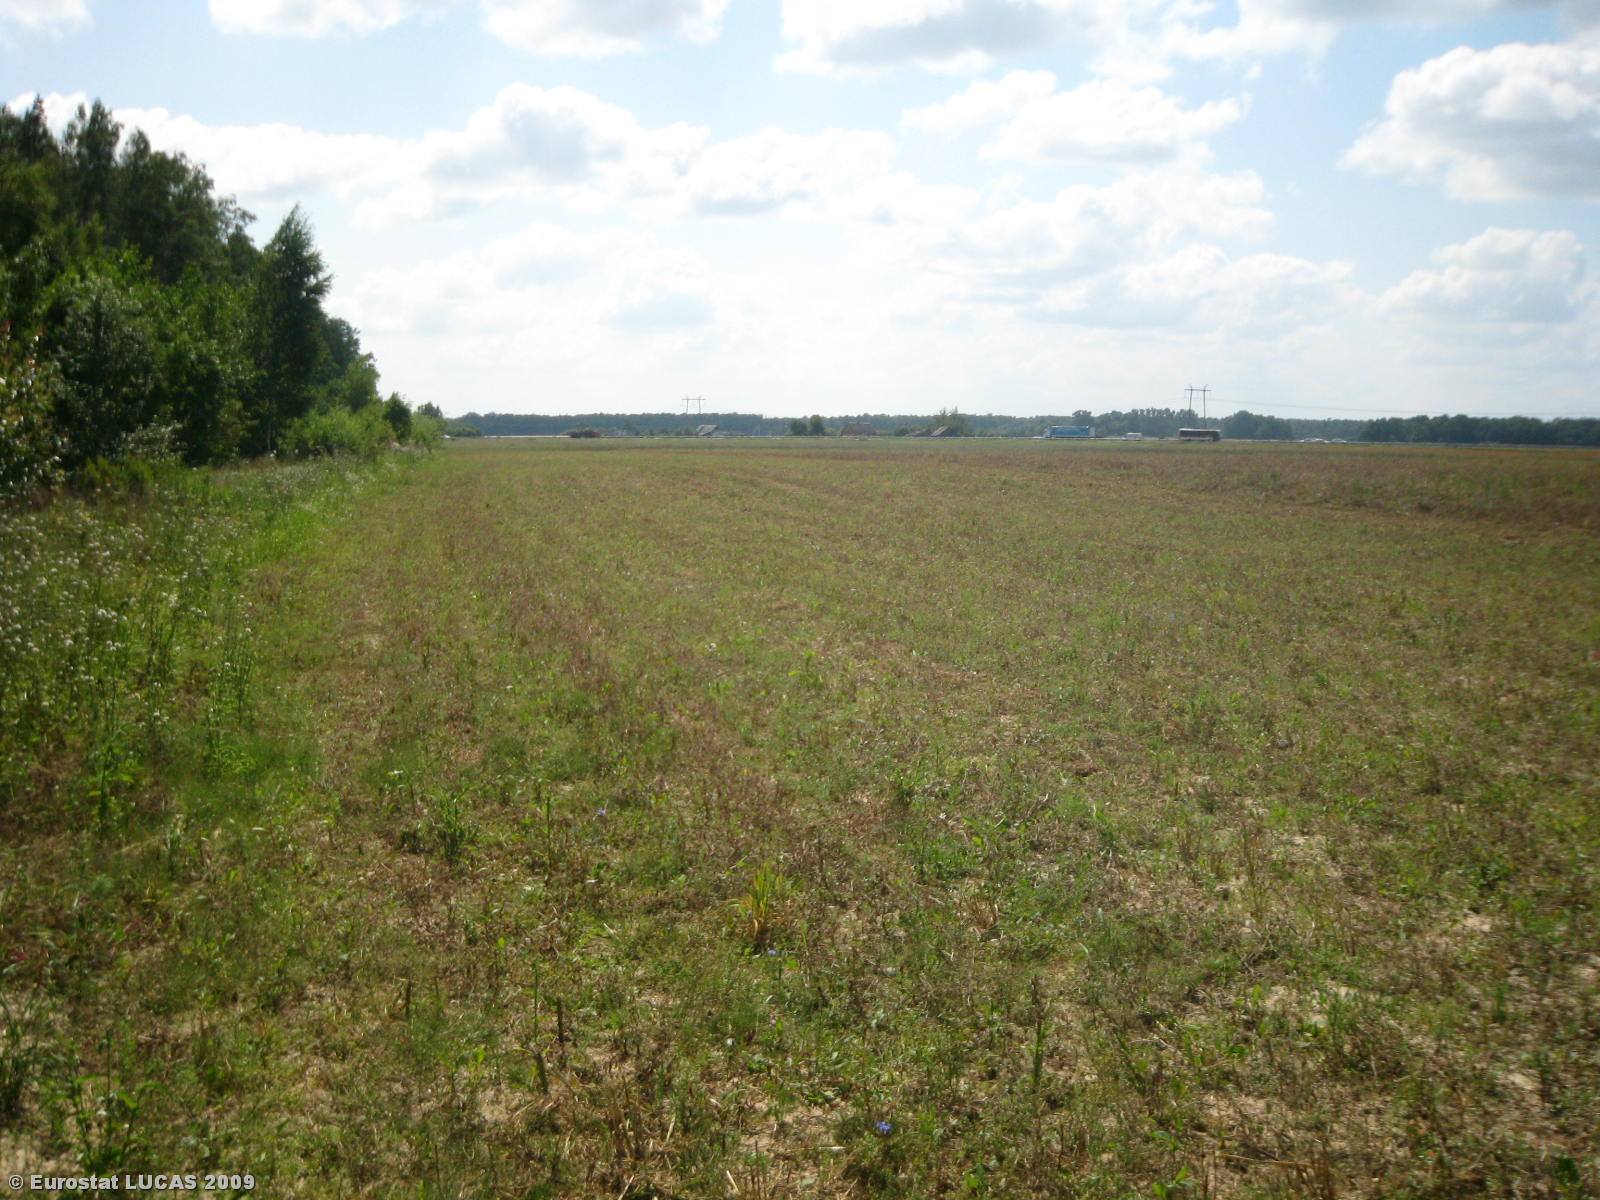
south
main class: Grassland
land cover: Spontaneously vegetated surfaces
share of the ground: > 75 %
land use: Fallow land
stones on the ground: < 10 %
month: August
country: LT
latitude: 55.1780
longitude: 23.6662
